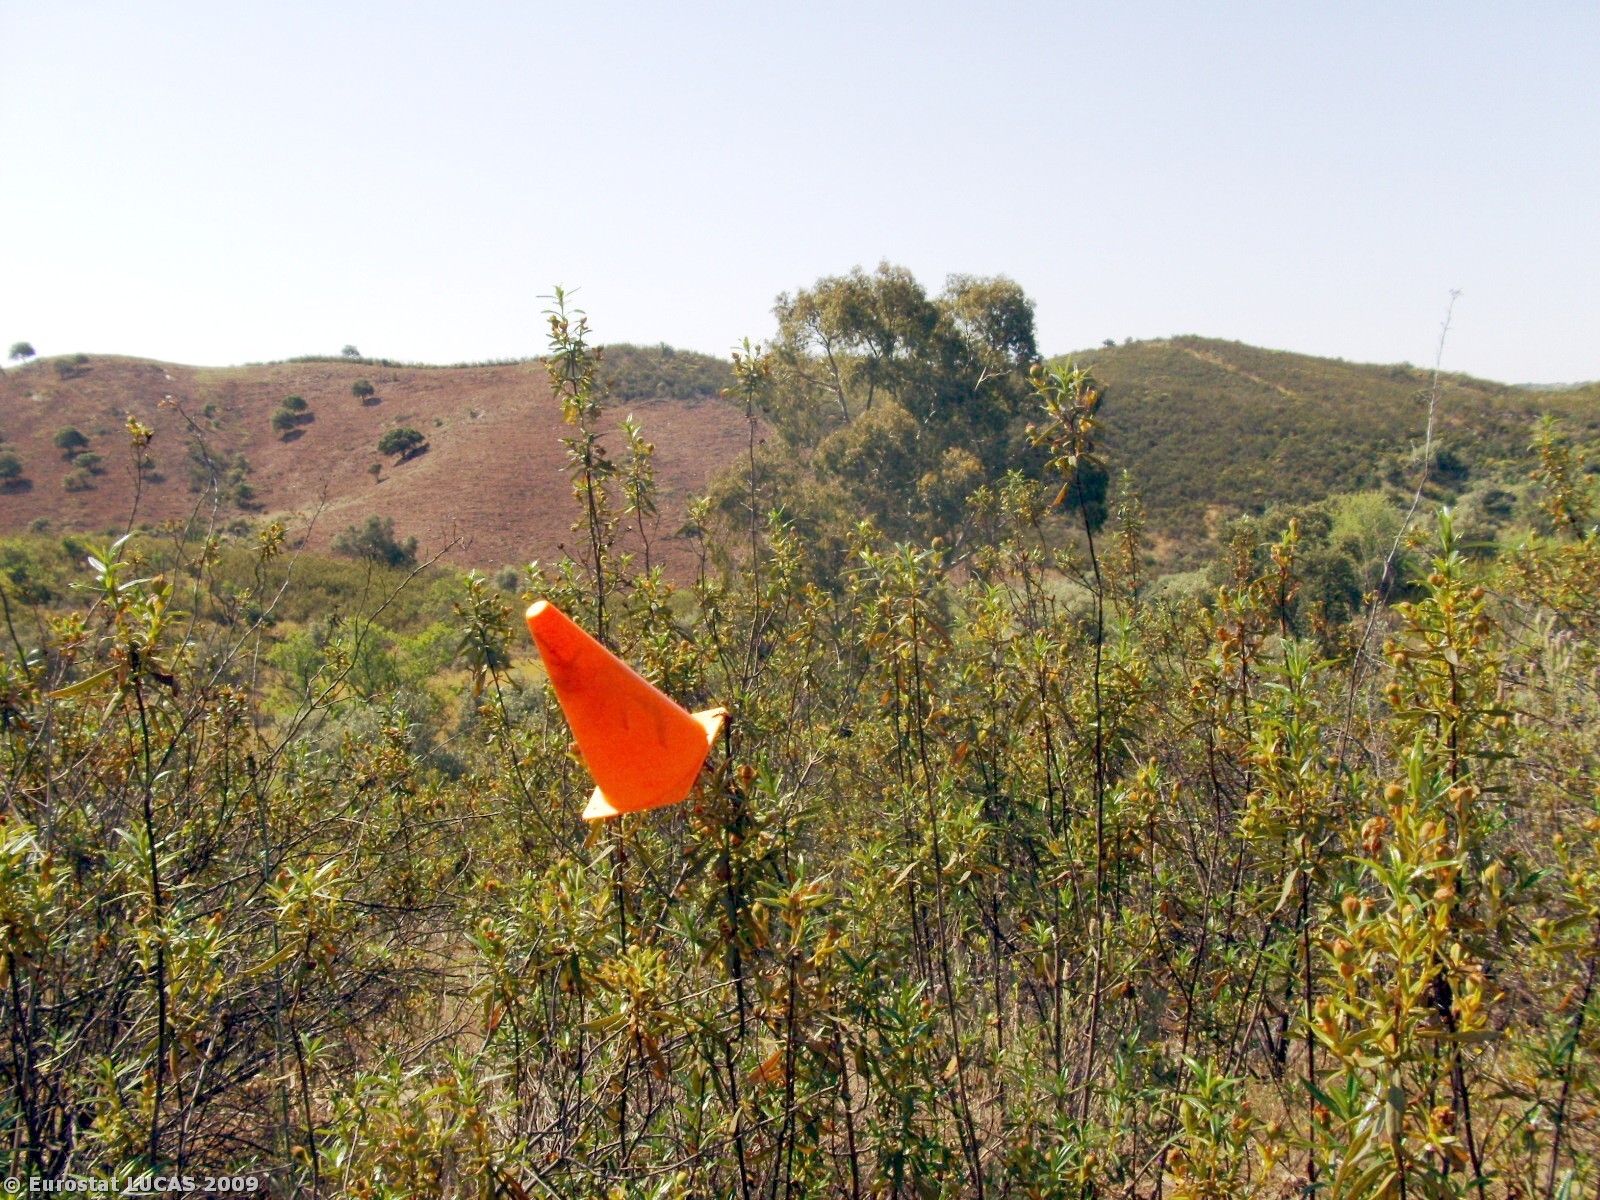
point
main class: Shrubland
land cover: Shrubland with sparse tree cover
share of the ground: > 75 %
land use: Fallow land
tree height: > 5 m
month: May
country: PT
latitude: 37.5072
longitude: -7.6490
